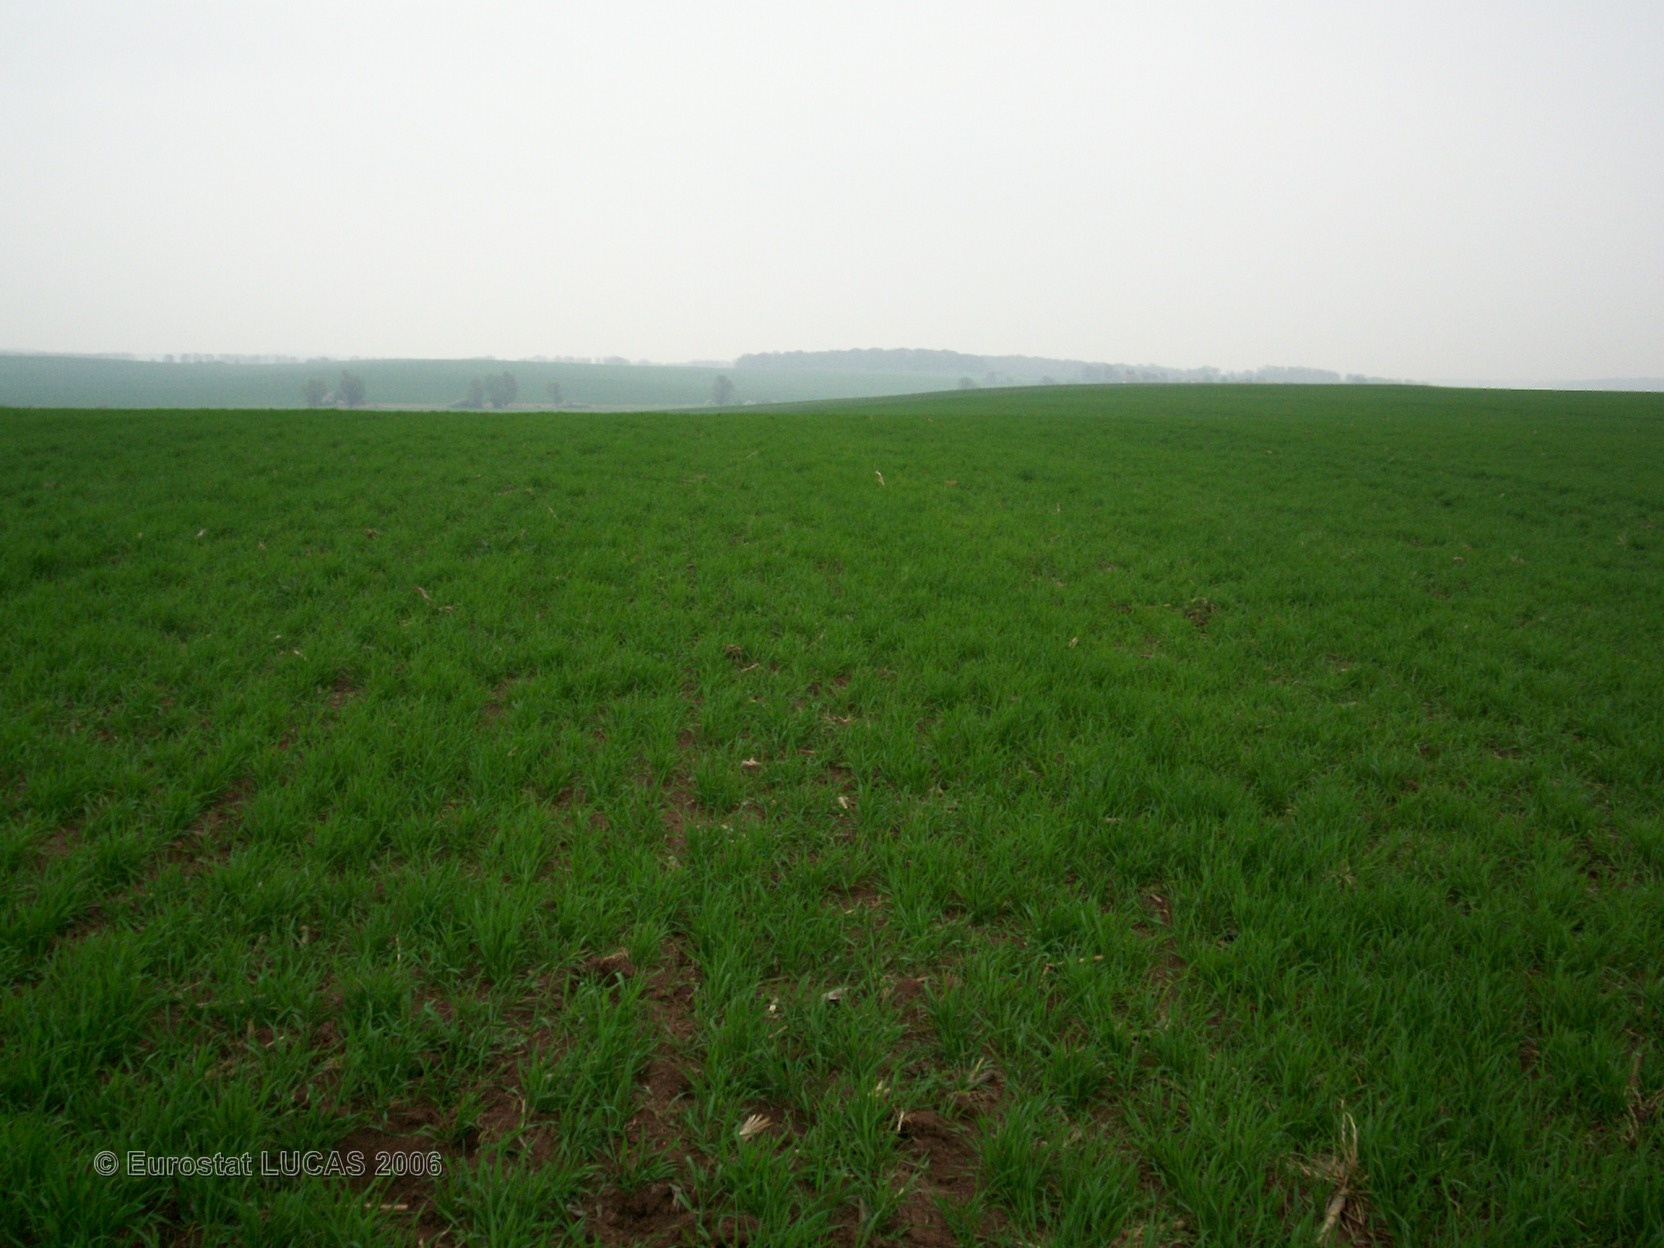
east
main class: Cropland
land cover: Common wheat
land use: Agriculture (excluding fallow land and kitchen gardens)
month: April
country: FR
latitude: 48.9496
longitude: 6.7367
